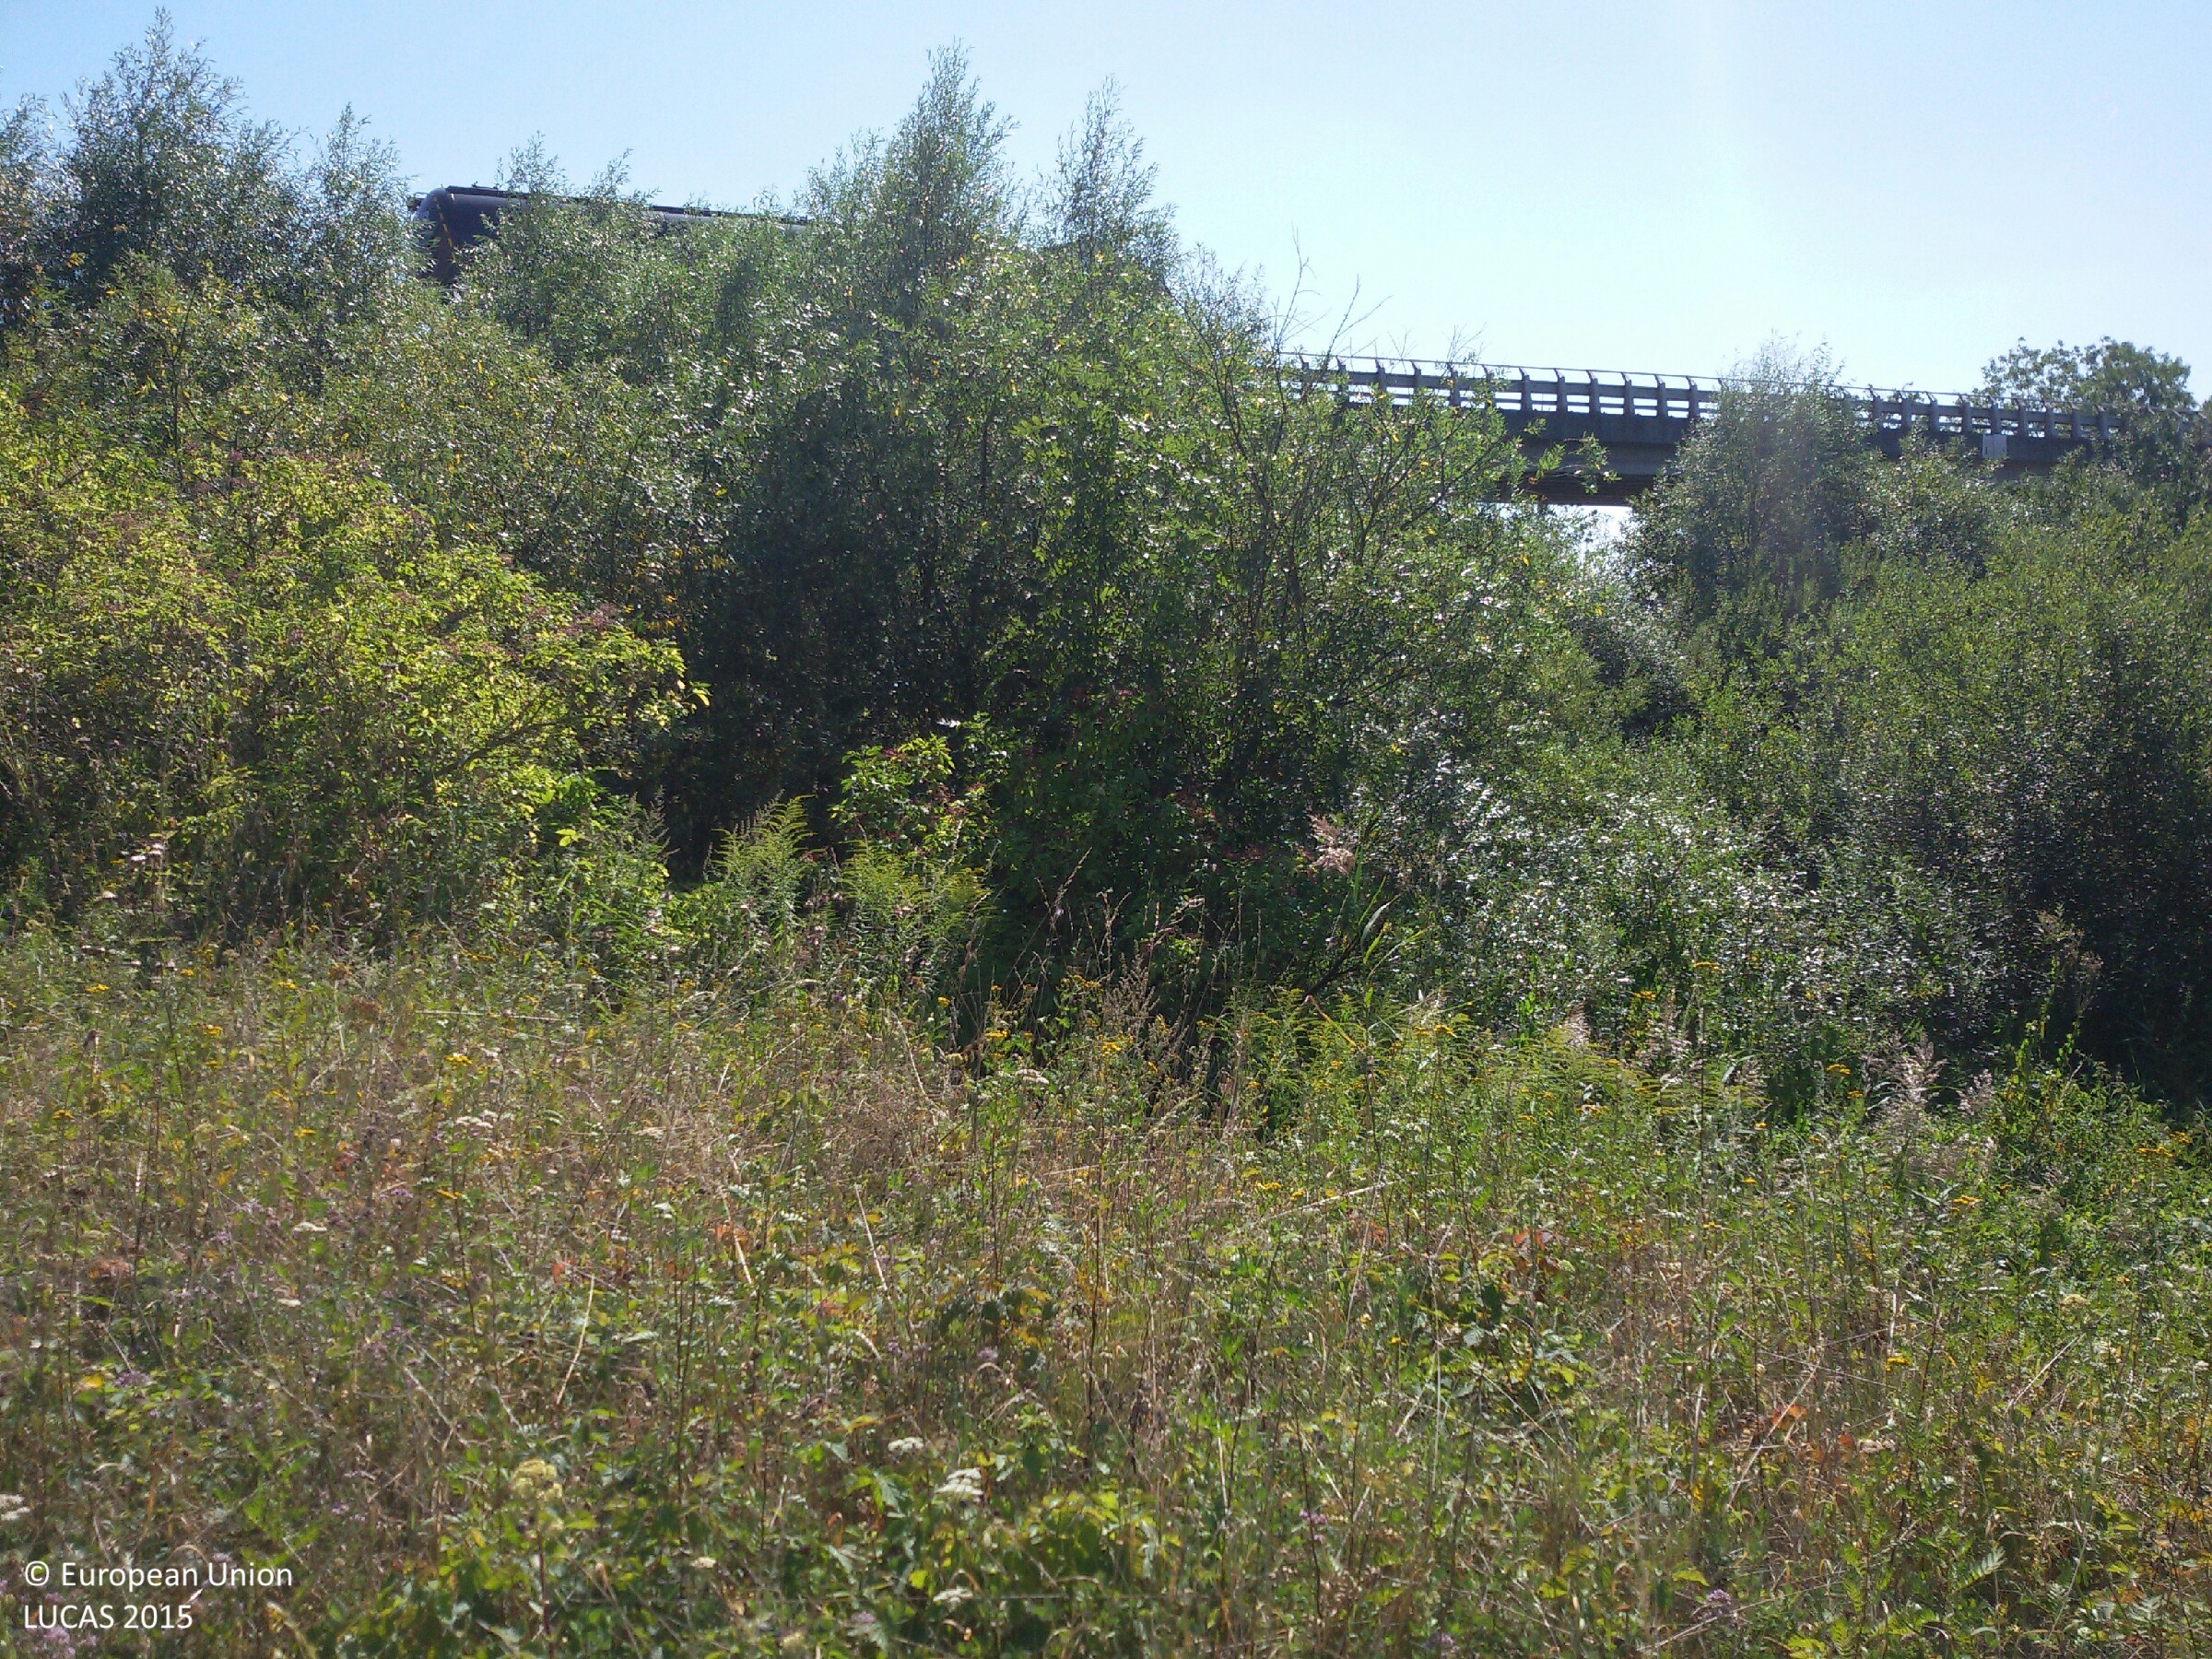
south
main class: Grassland
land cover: Spontaneously vegetated surfaces
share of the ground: > 75 %
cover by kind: herbaceous plants 95 %, shrubs 5 %
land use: Semi-natural and natural areas not in use
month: August
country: PL
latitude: 54.1417
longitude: 19.3777
